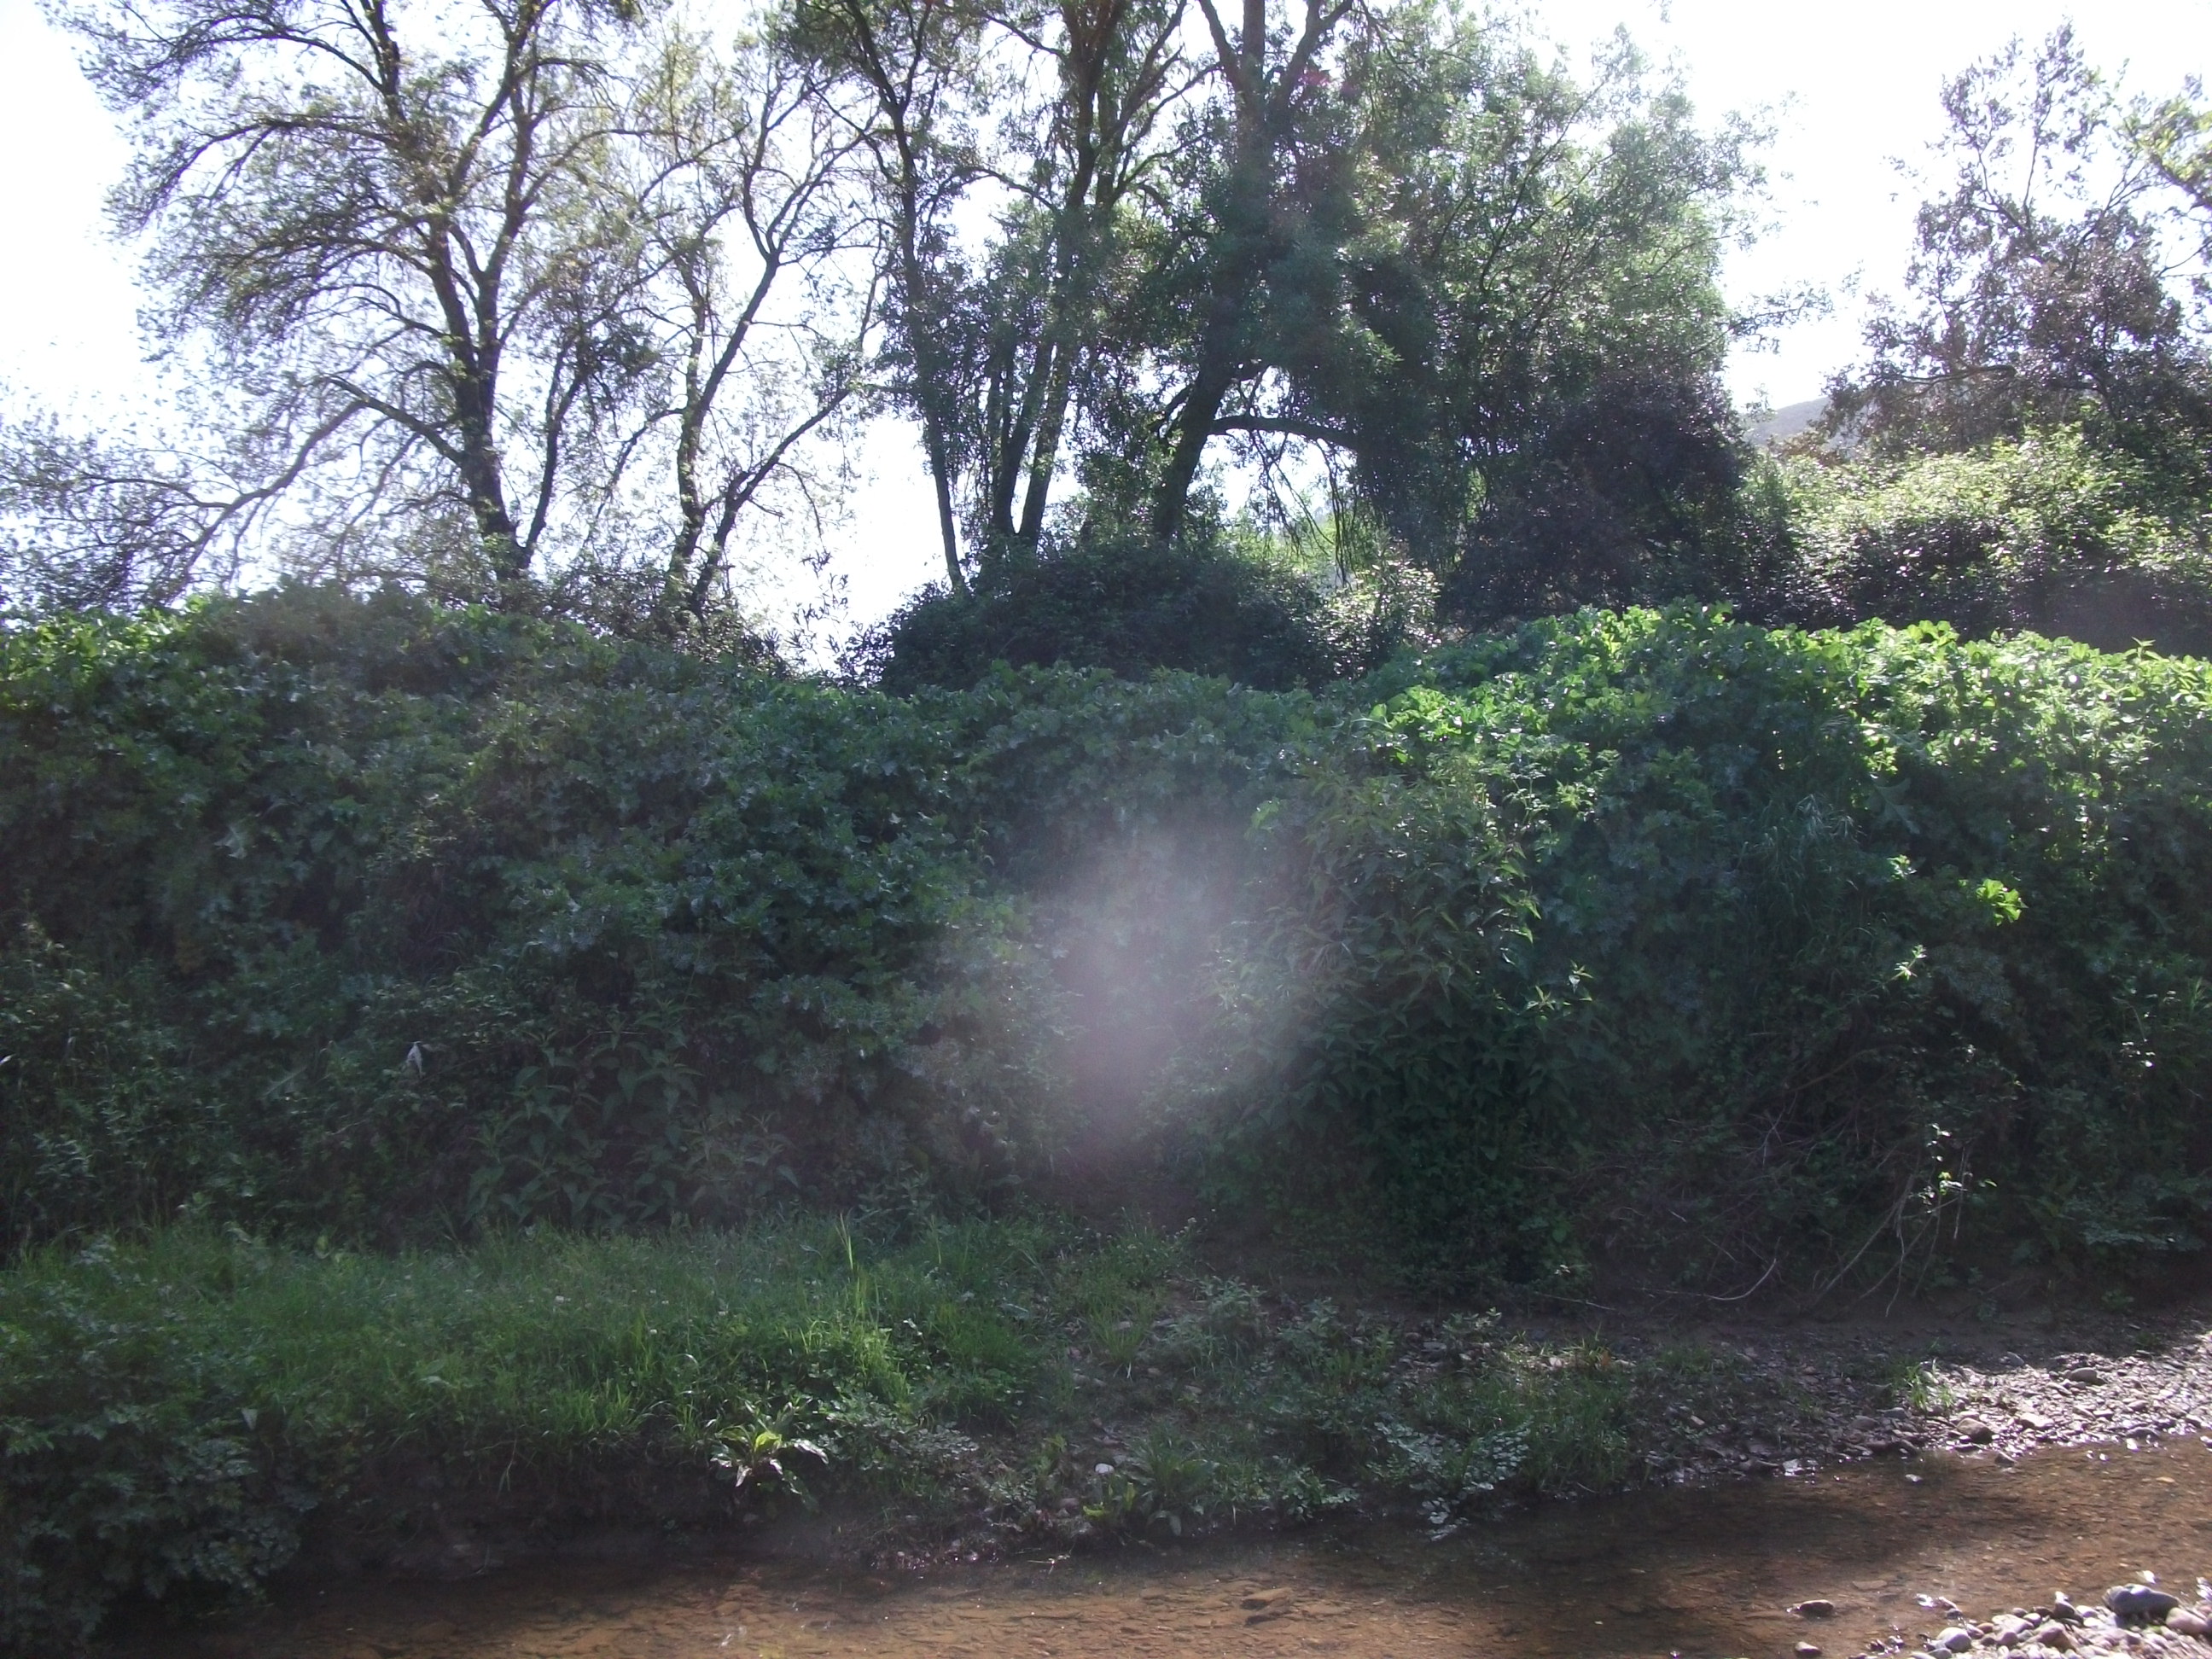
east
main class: Woodland
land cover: Broadleaved woodland
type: broadleaved evergreen forest
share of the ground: 25 - 50 %
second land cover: Grassland without tree/shrub cover
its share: > 75 %
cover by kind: herbaceous plants 60 %, broadleaved forest trees 40 %
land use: Forestry
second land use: Agriculture (excluding fallow land and kitchen gardens)
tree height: > 5 m
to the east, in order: Broadleaved woodland; Grassland without tree/shrub cover; Rivers and streams; Broadleaved woodland; Rock outcrops; Broadleaved woodland; Fences; Grass margins; Tracks; Grass margins; Paved roads, cycling and walking lanes; Ditches and canals; Grass margins; Fences; Broadleaved woodland
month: April
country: ES
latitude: 37.9855
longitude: -6.7516
